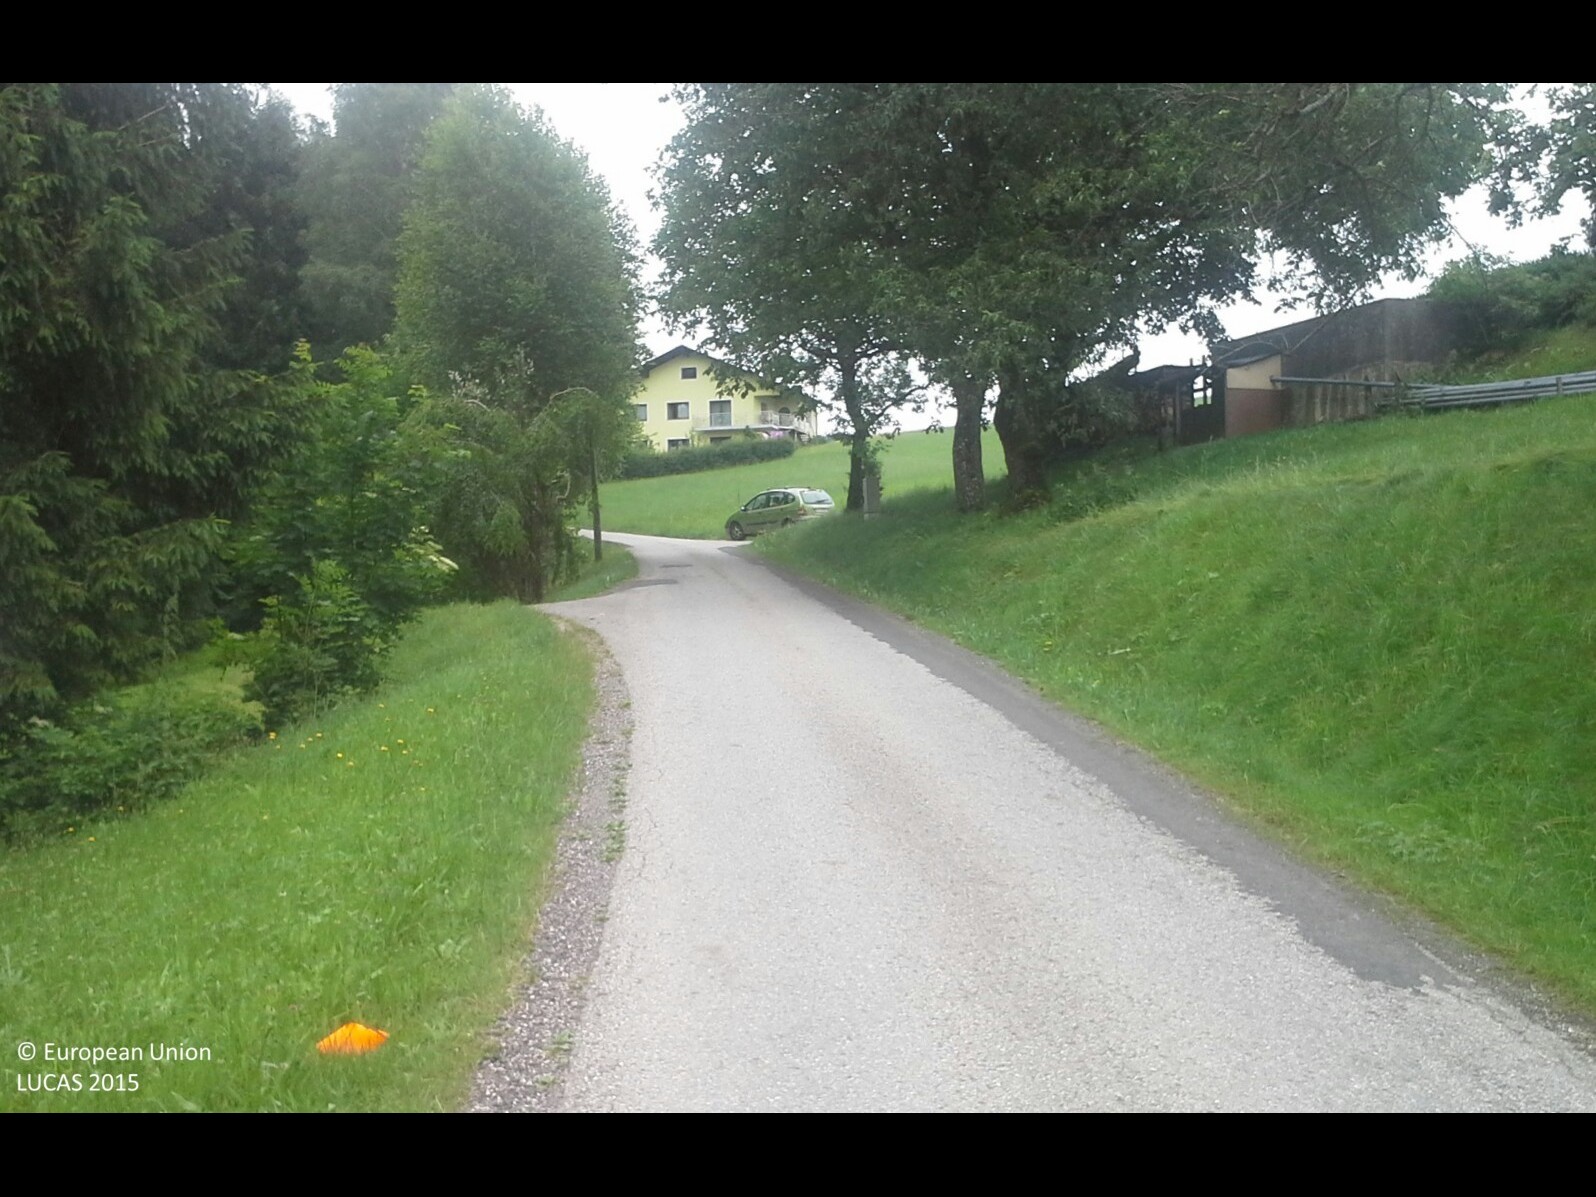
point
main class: Grassland
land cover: Grassland without tree/shrub cover
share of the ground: > 75 %
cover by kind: herbaceous plants 100 %
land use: Agriculture (excluding fallow land and kitchen gardens)
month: June
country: AT
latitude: 47.9775
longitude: 14.3001
